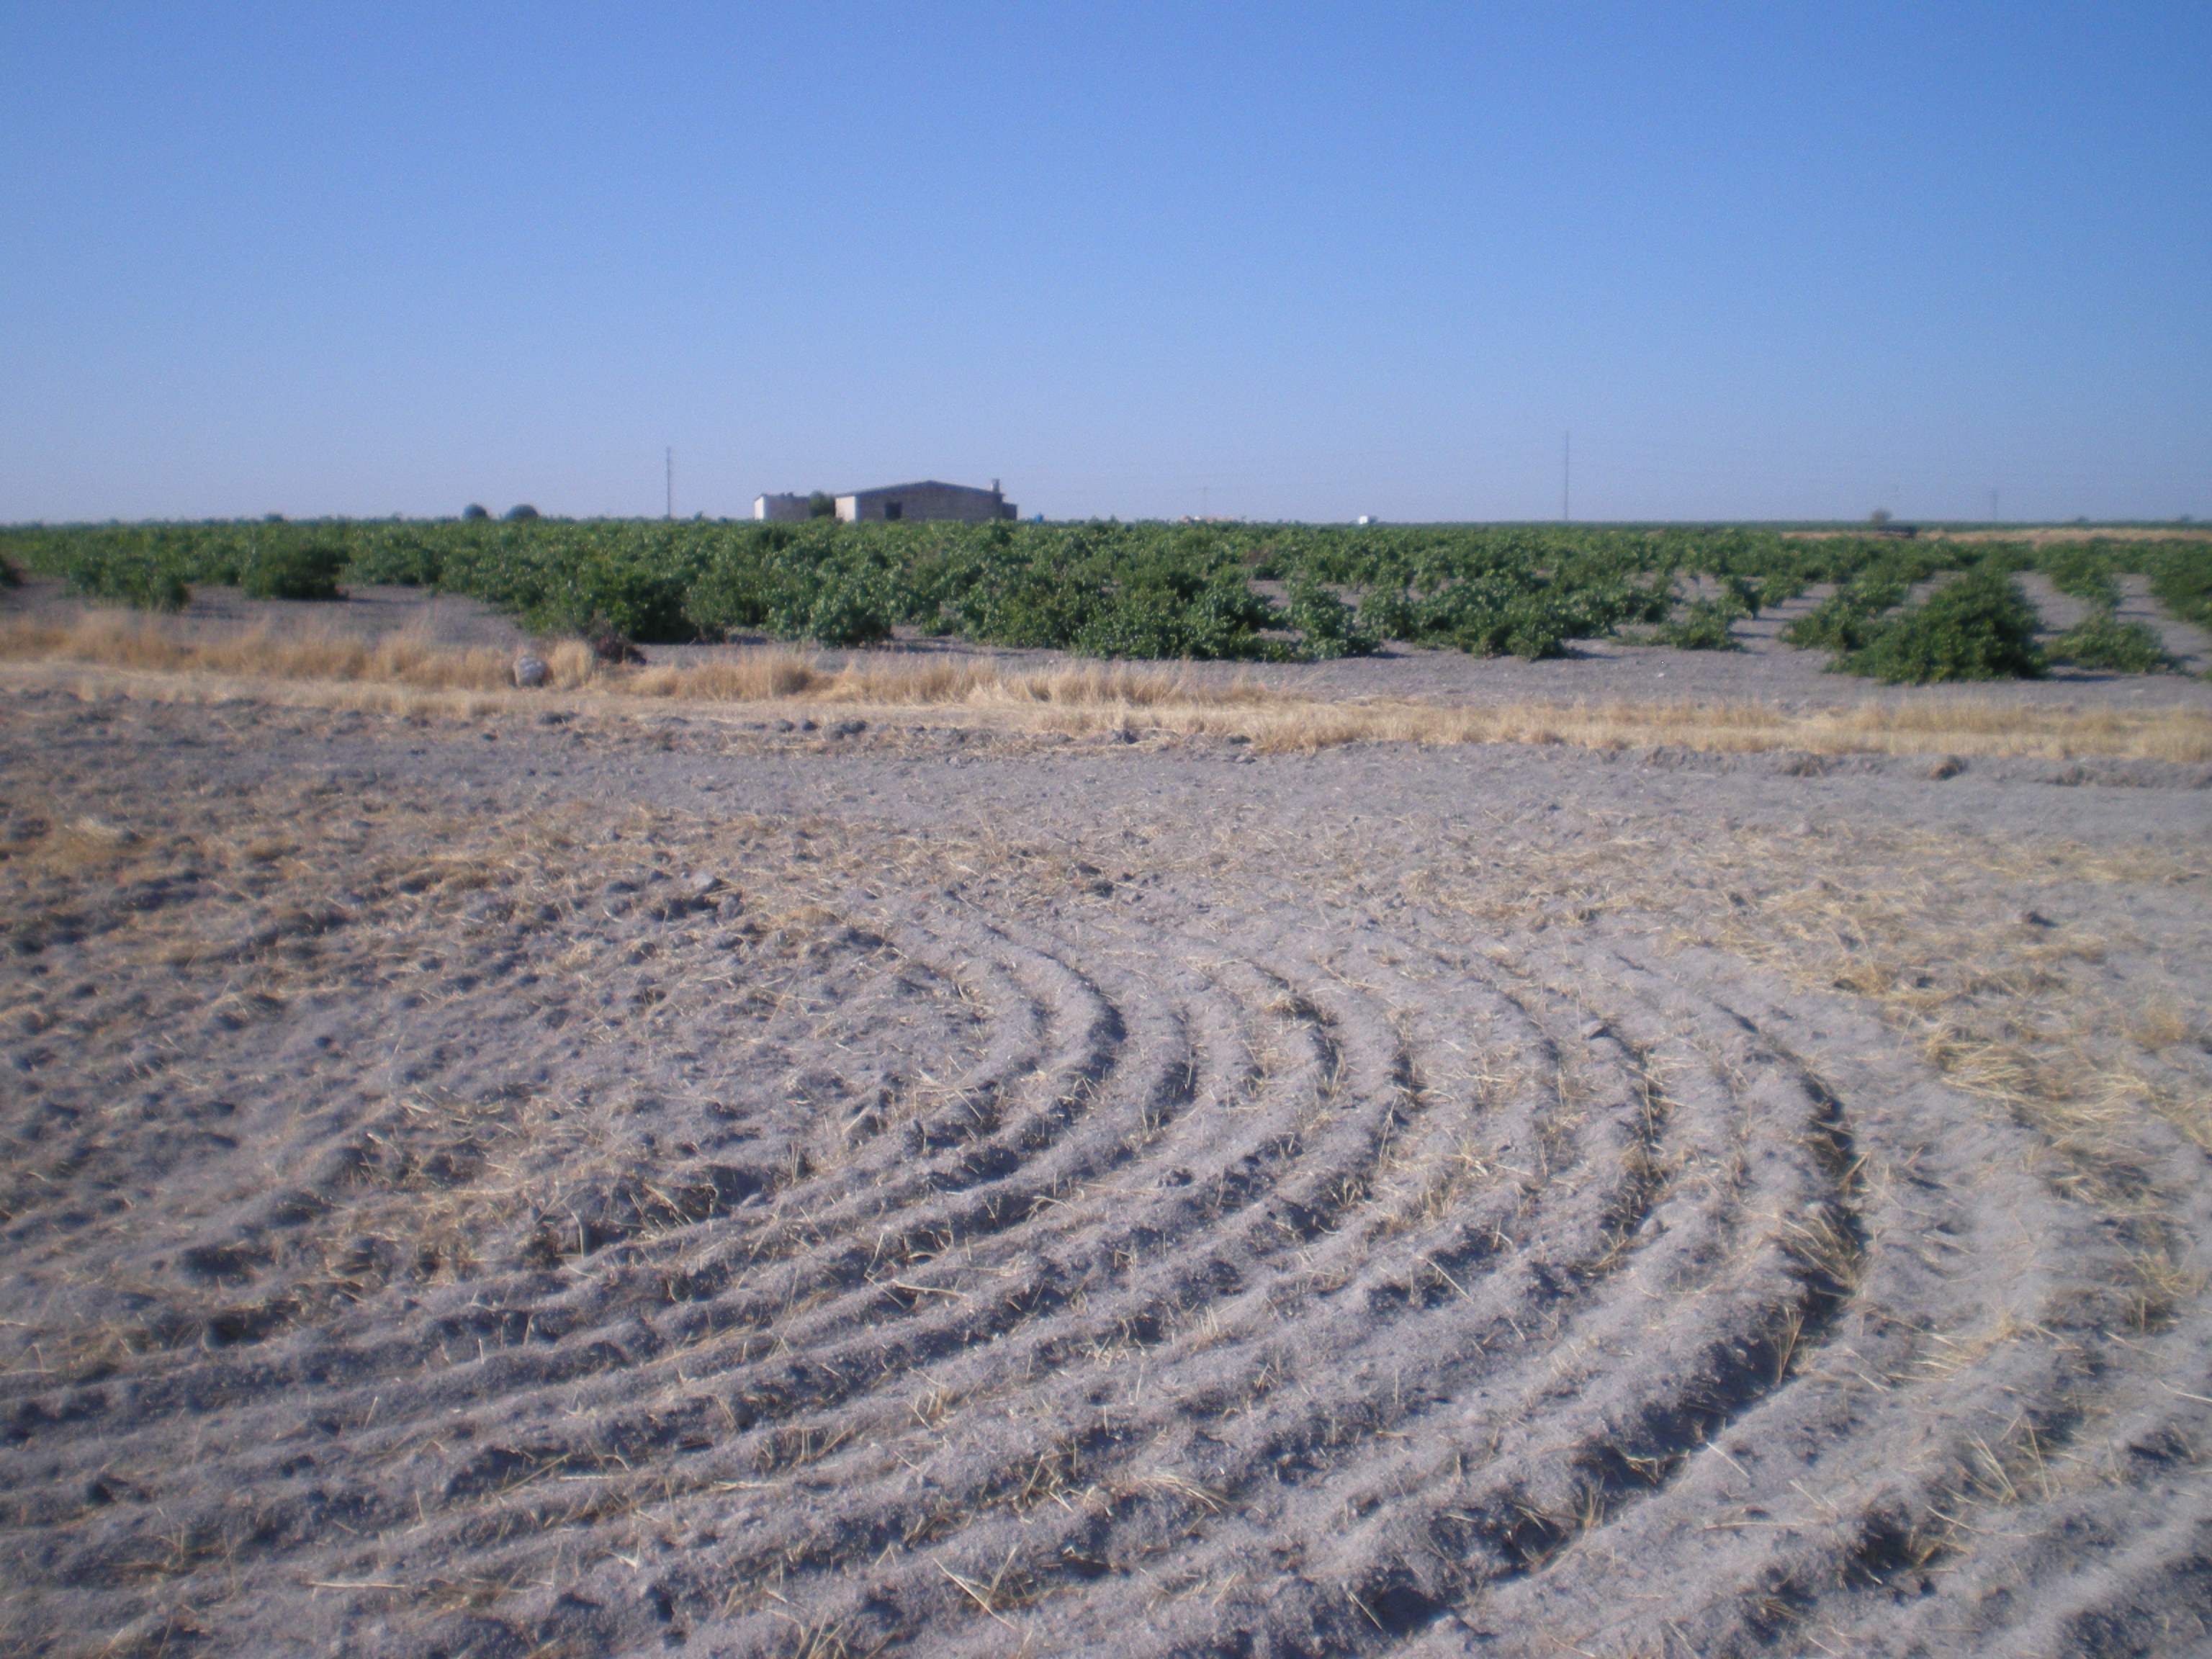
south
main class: Cropland
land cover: Common wheat
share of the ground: < 10 %
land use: Agriculture (excluding fallow land and kitchen gardens)
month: July
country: ES
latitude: 39.2968
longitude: -3.3410
